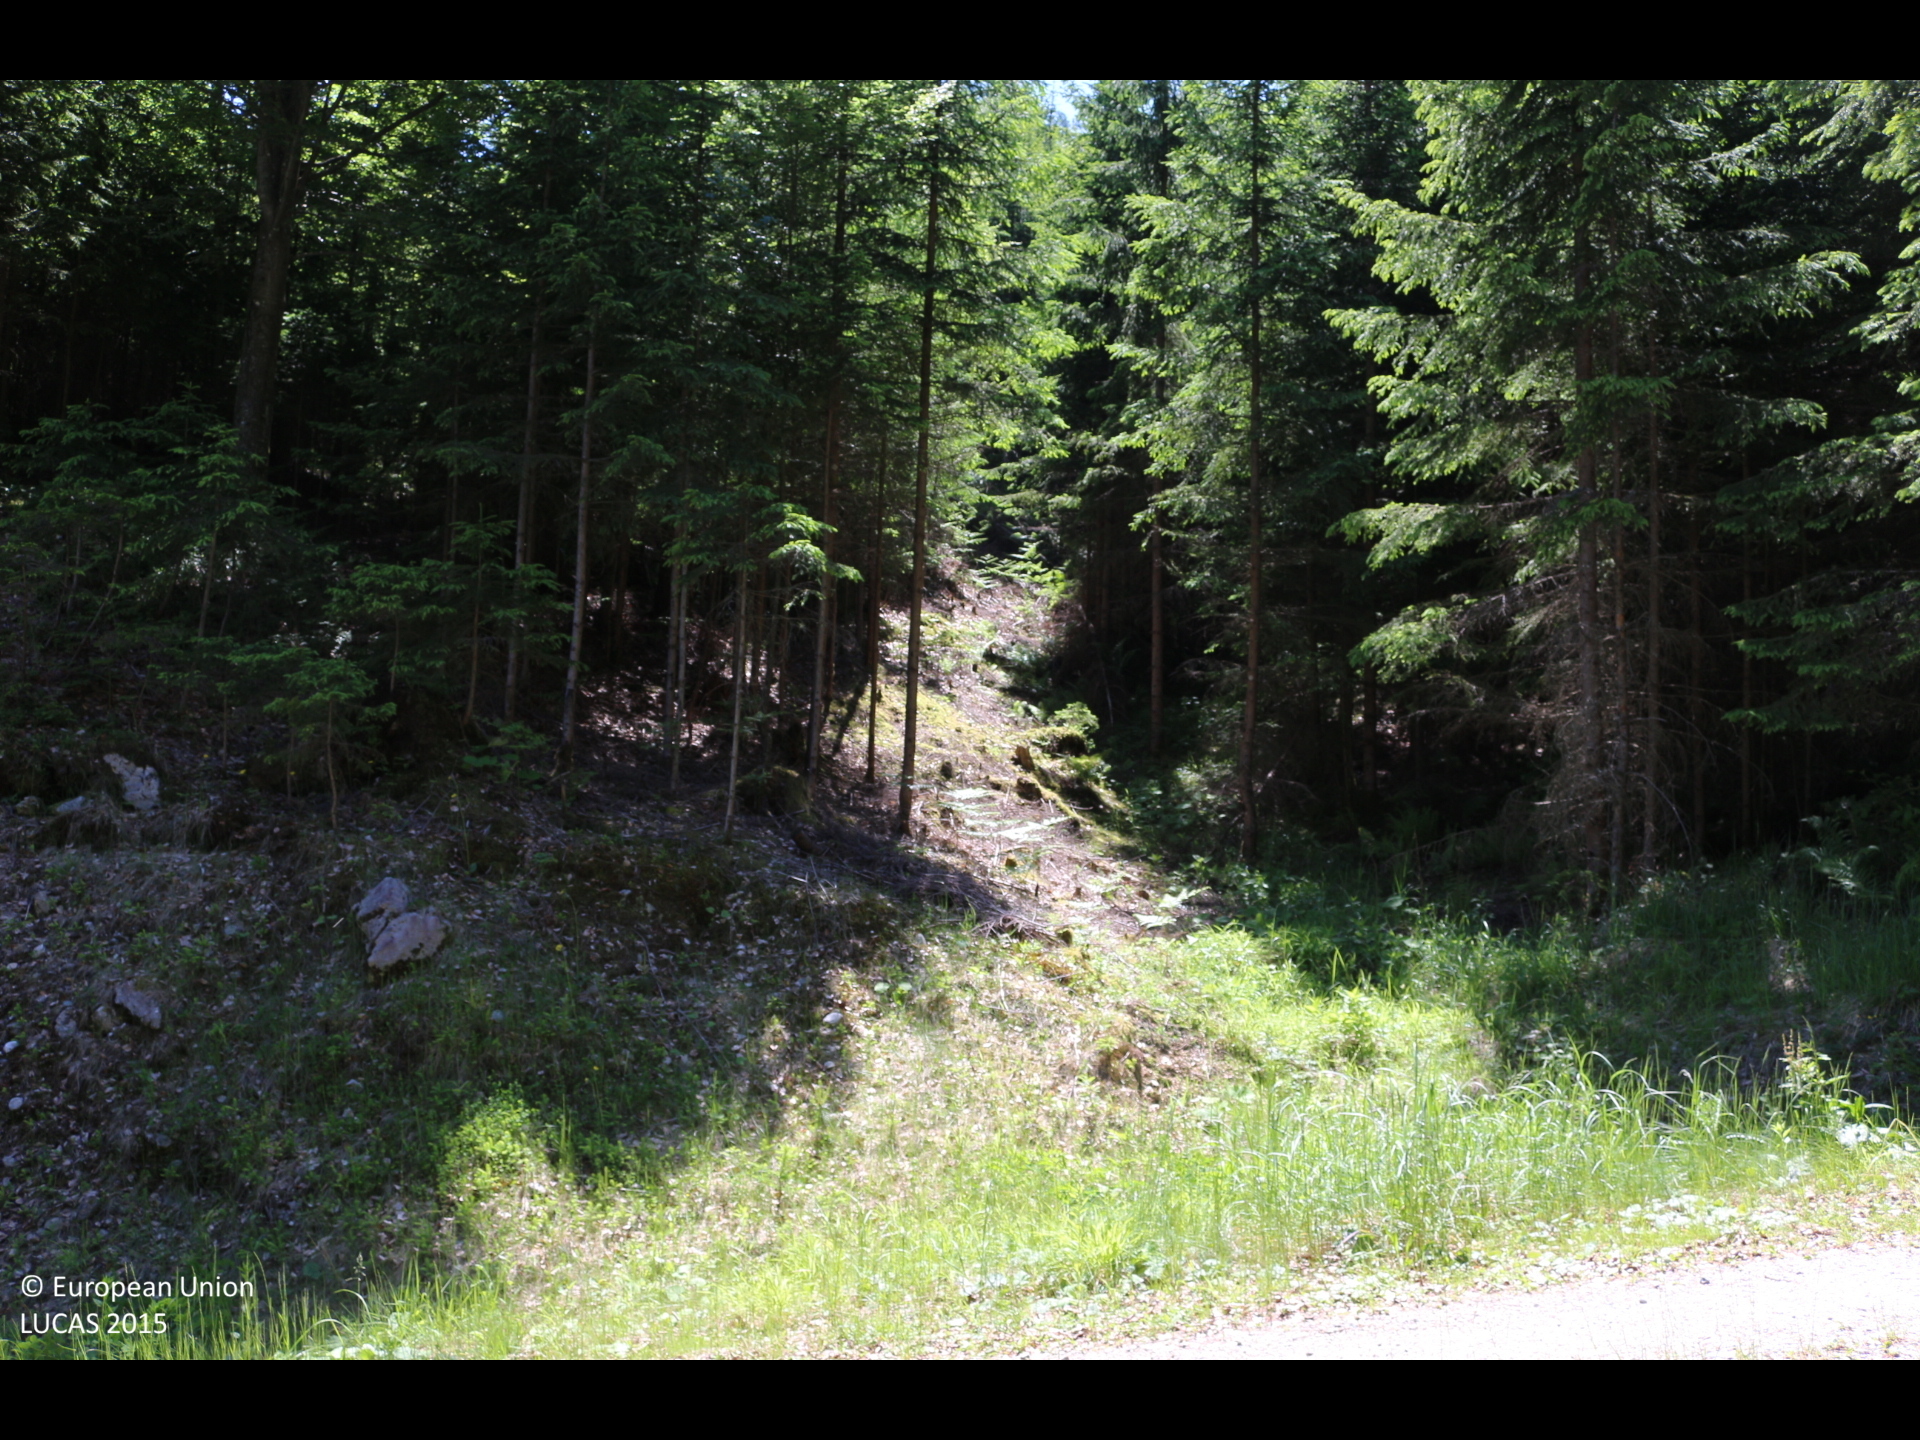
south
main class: Woodland
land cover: Spruce dominated mixed woodland
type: mountainous beech forest
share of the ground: > 75 %
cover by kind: coniferous forest trees 60 %, broadleaved forest trees 35 %, herbaceous plants 5 %
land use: Forestry
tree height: > 5 m
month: May
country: AT
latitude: 46.5279
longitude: 14.0255
